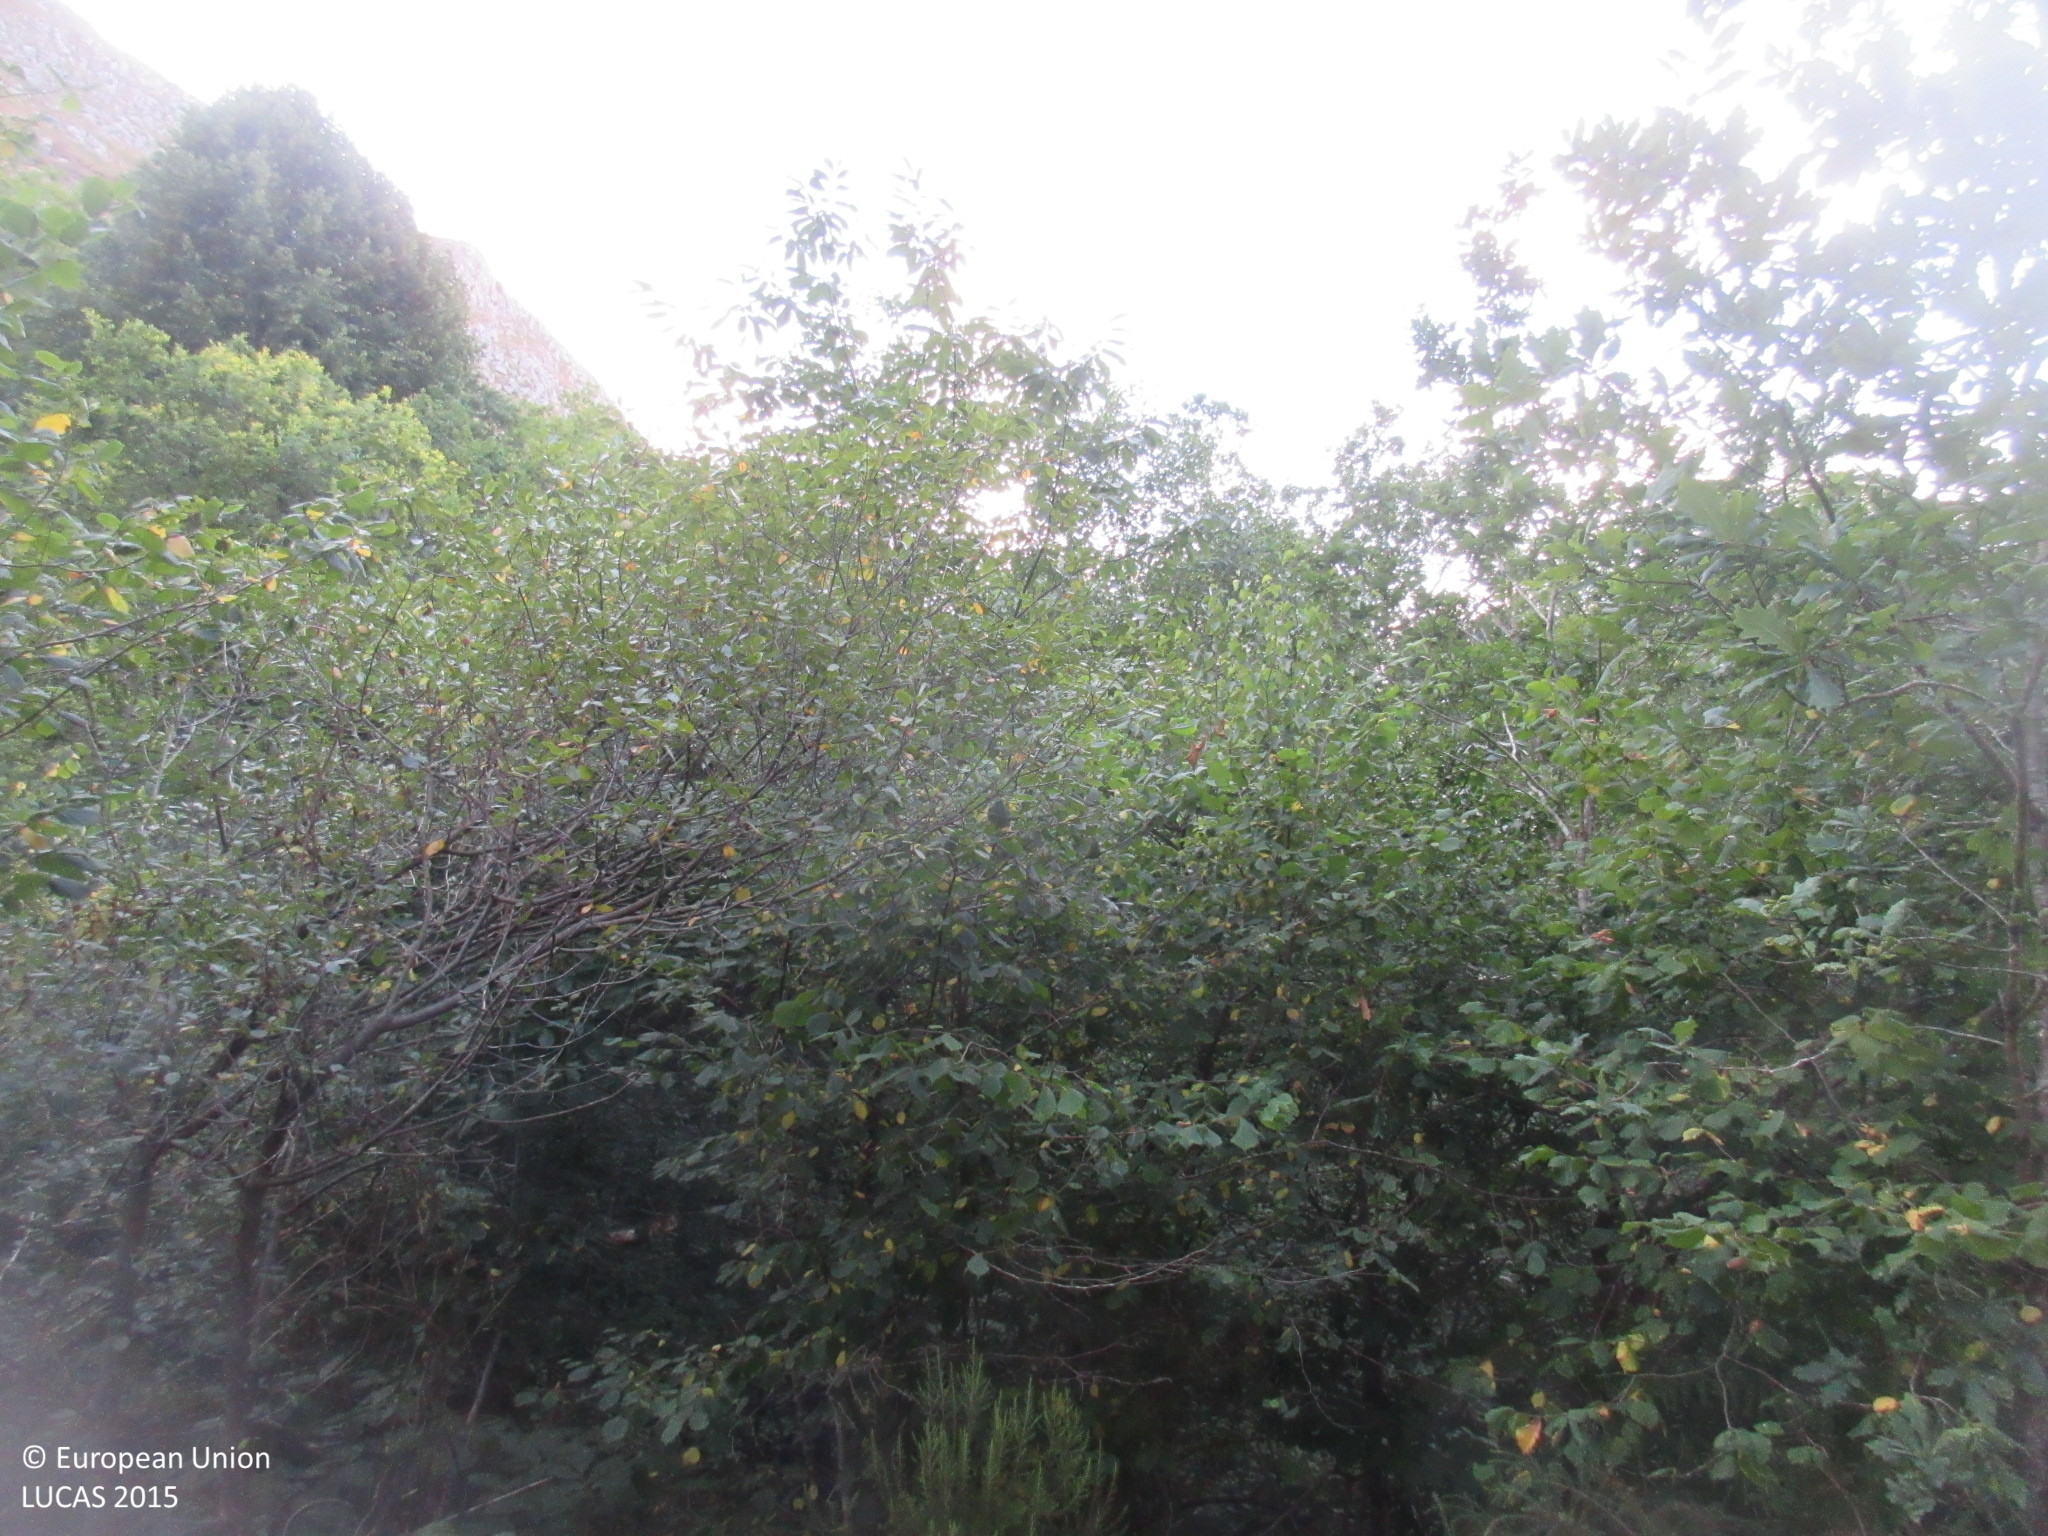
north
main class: Grassland
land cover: Grassland without tree/shrub cover
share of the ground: > 75 %
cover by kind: herbaceous plants 80 %, consolidated bare surface 20 %
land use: Agriculture (excluding fallow land and kitchen gardens)
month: July
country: ES
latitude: 43.3854
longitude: -5.0947
